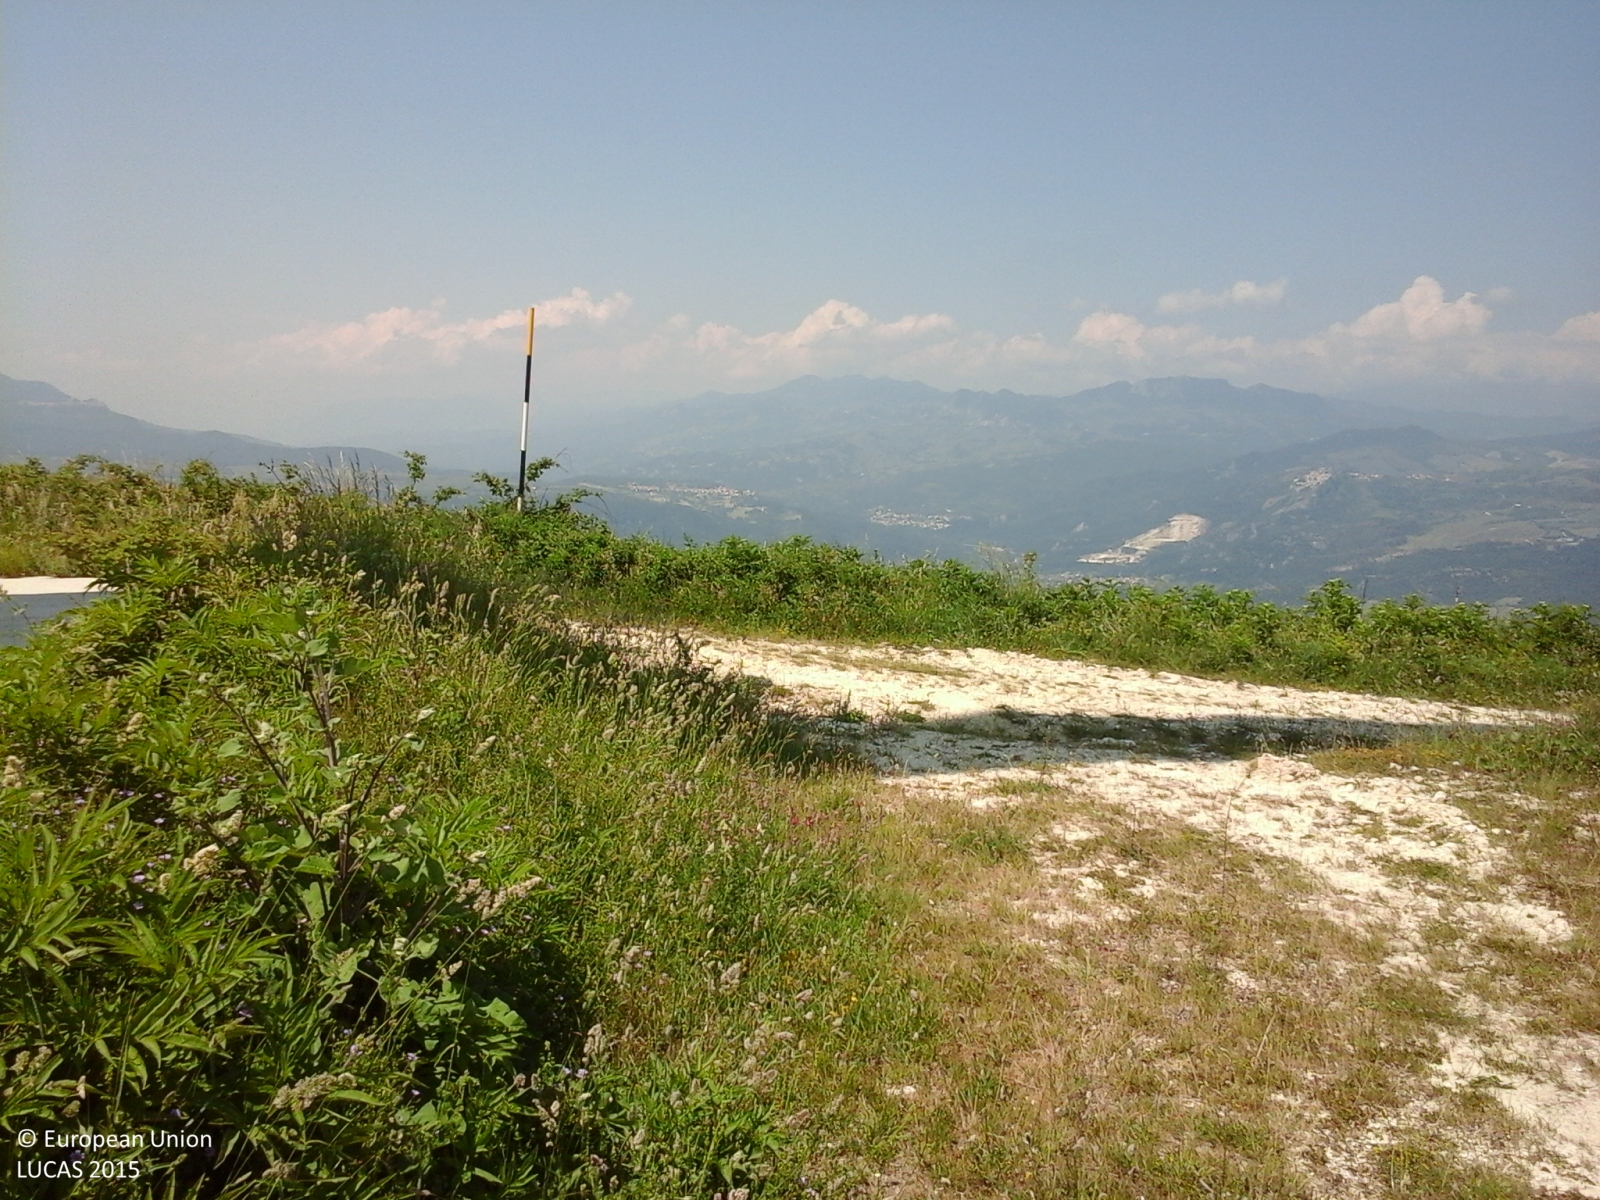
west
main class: Grassland
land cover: Grassland without tree/shrub cover
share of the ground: > 75 %
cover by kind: herbaceous plants 100 %
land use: Energy production
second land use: Agriculture (excluding fallow land and kitchen gardens)
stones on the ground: 10 - 25 %
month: June
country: IT
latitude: 41.9439
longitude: 14.3884
